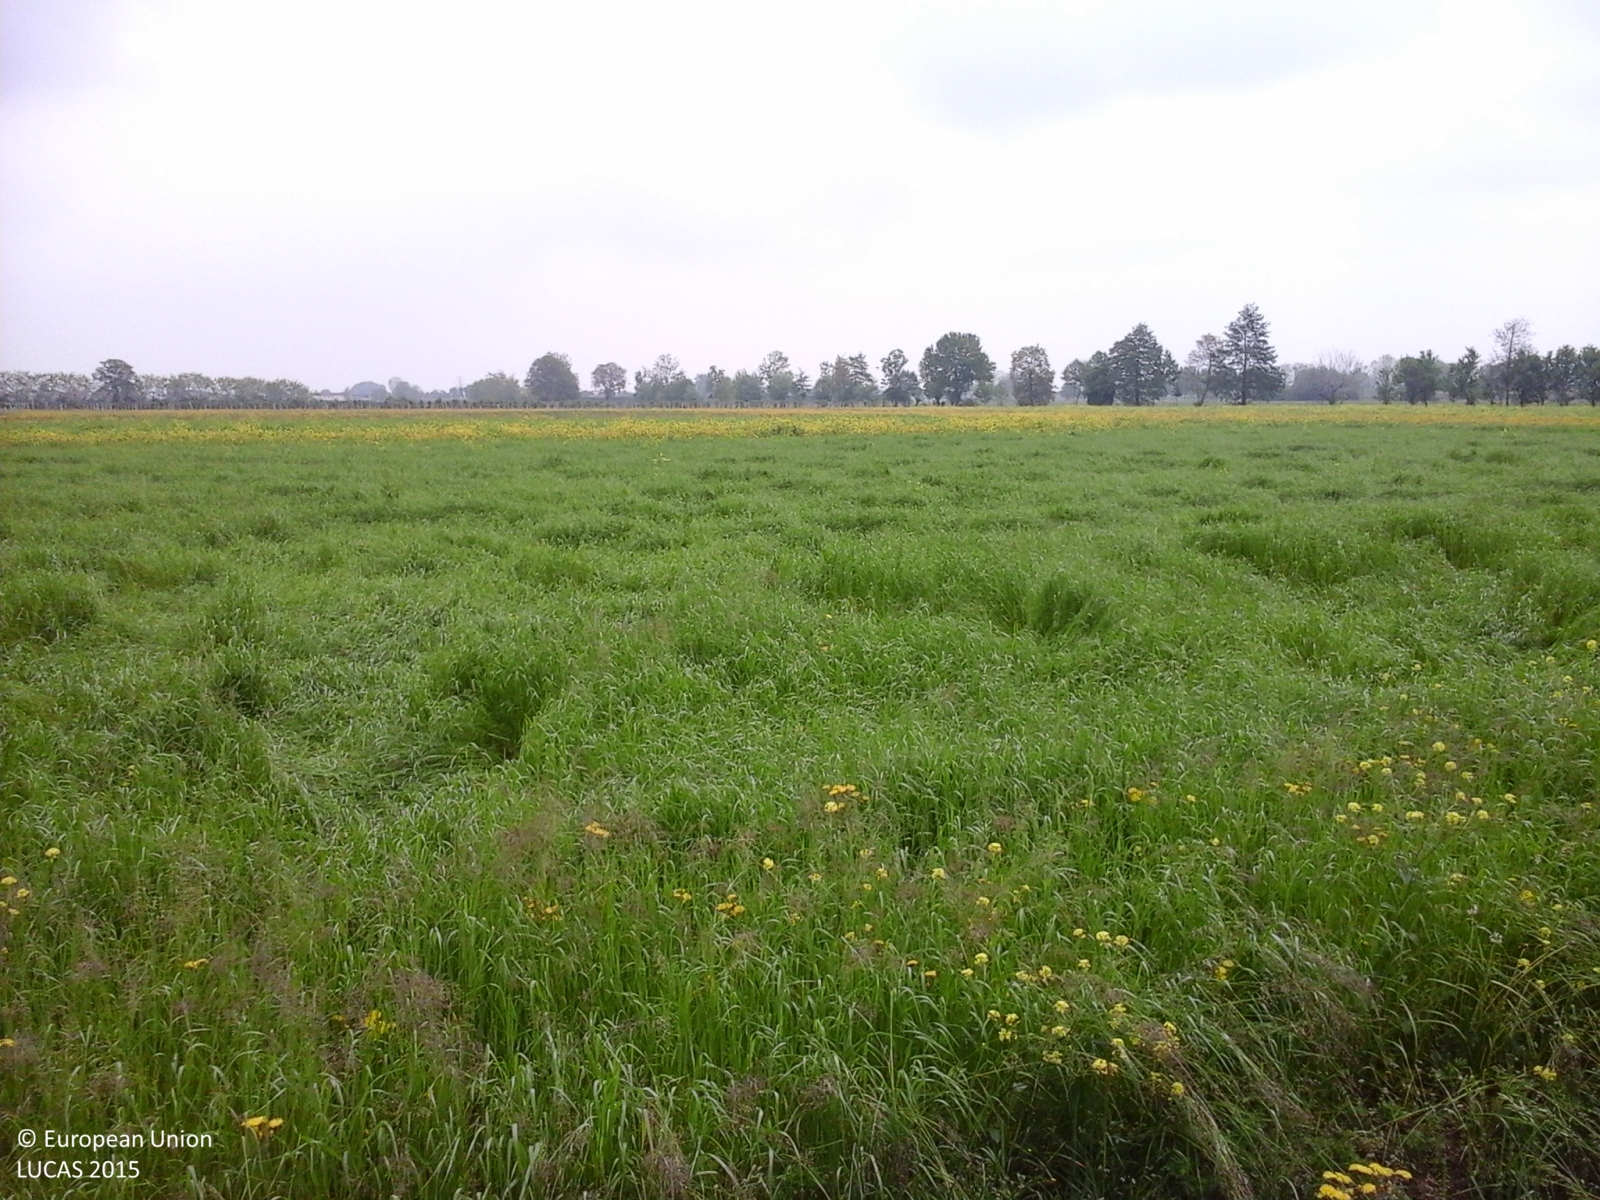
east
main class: Cropland
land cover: Temporary grasslands
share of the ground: > 75 %
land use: Agriculture (excluding fallow land and kitchen gardens)
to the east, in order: Temporary grasslands; Ditches and canals; Temporary grasslands; Ditches and canals; Temporary grasslands; Fences; Nuts trees
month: May
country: IT
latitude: 44.4631
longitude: 7.4286
